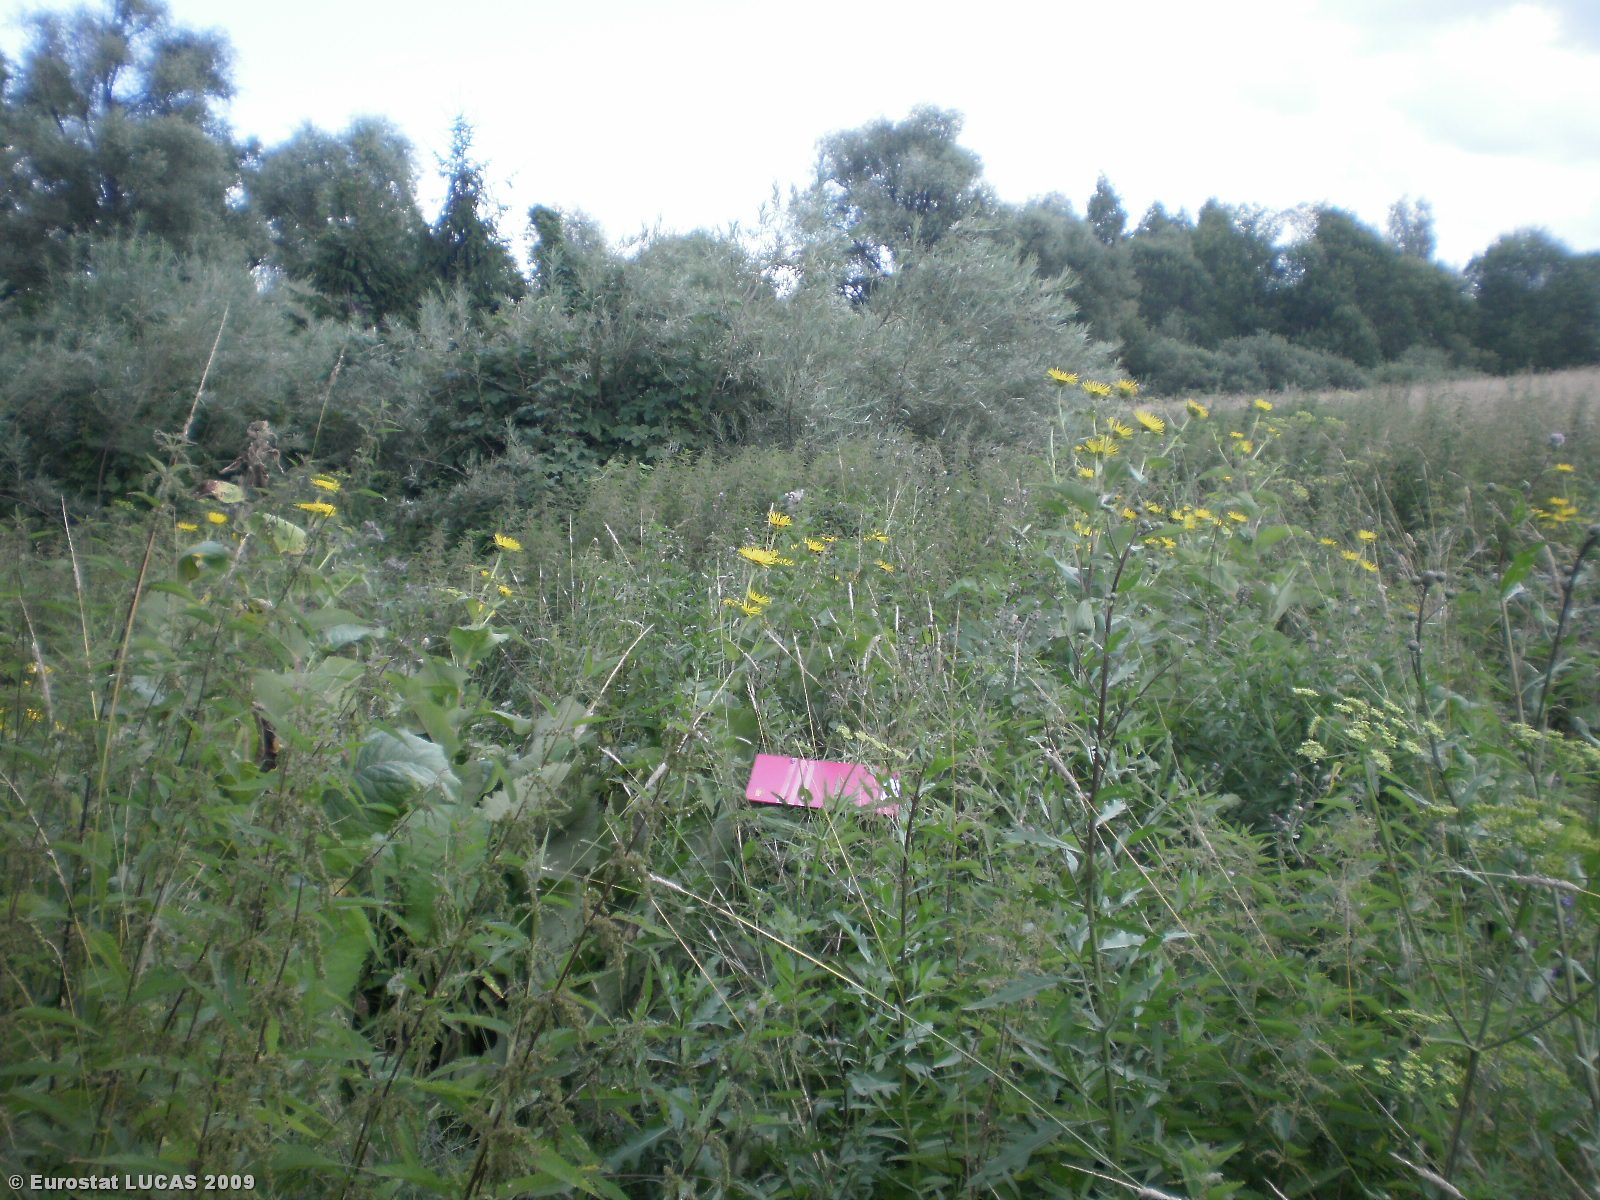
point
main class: Grassland
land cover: Spontaneously vegetated surfaces
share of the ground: > 75 %
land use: Unused
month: July
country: LT
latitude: 55.9204
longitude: 25.7635
